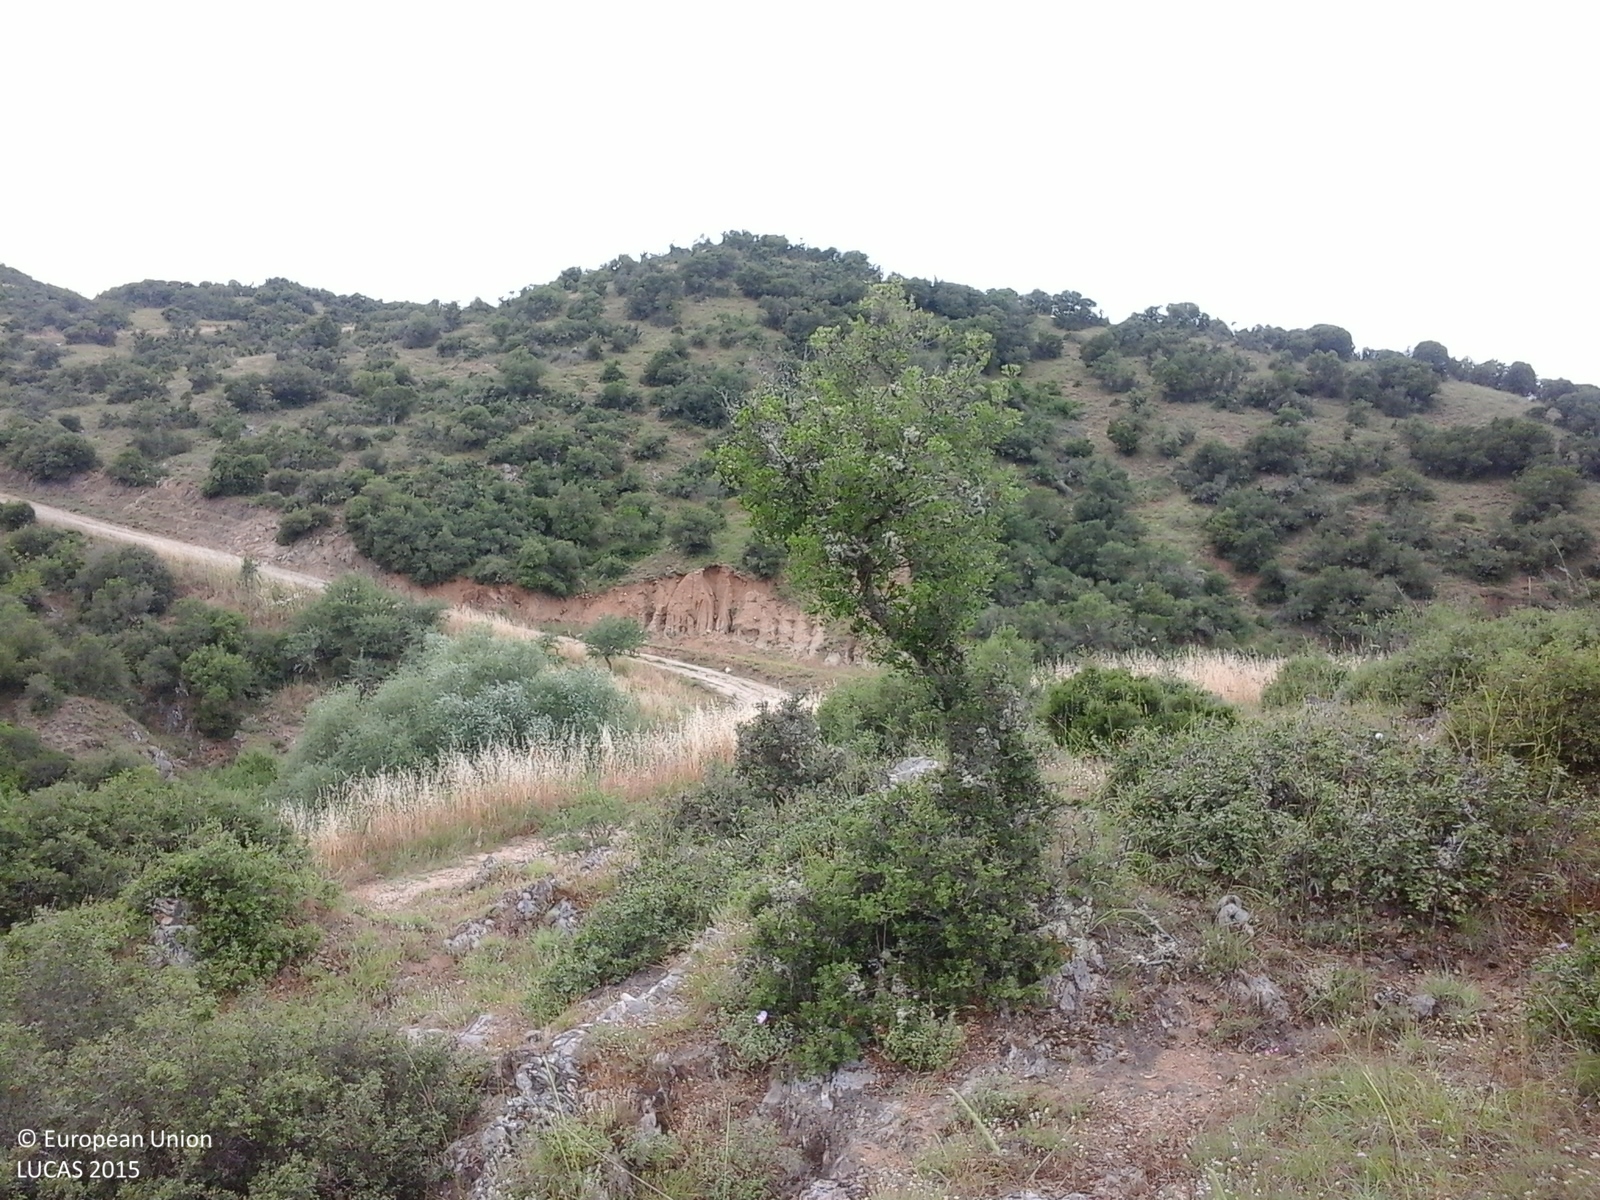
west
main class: Shrubland
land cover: Shrubland without tree cover
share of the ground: > 75 %
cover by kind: shrubs 90 %, herbaceous plants 10 %
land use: Semi-natural and natural areas not in use
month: June
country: GR
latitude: 40.7238
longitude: 23.2121
